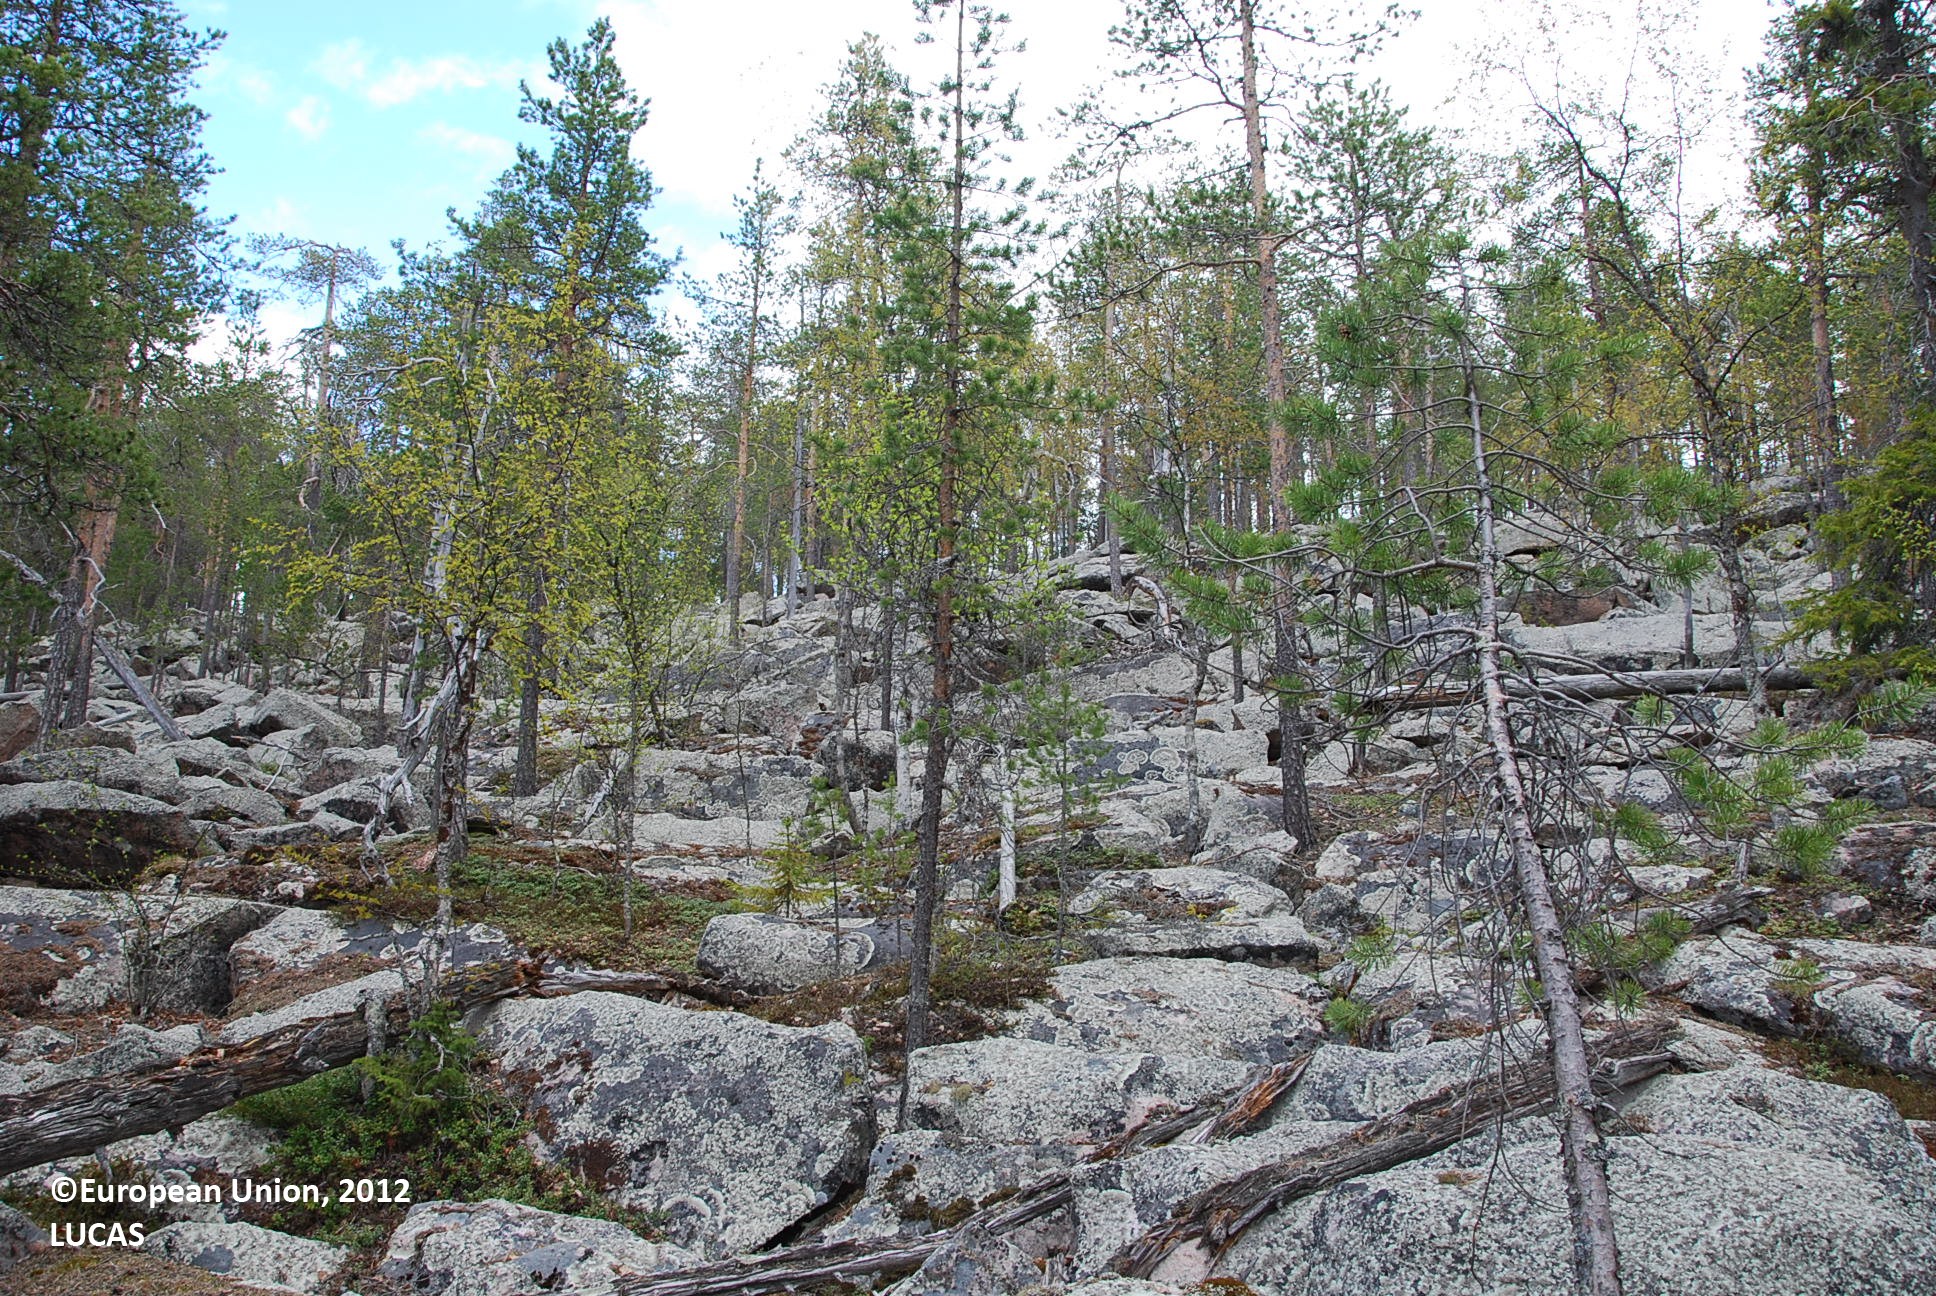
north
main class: Woodland
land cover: Pine dominated coniferous woodland
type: boreal forest
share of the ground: 25 - 50 %
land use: Forestry
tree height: > 5 m
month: May
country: FI
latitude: 66.8914
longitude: 28.2842
